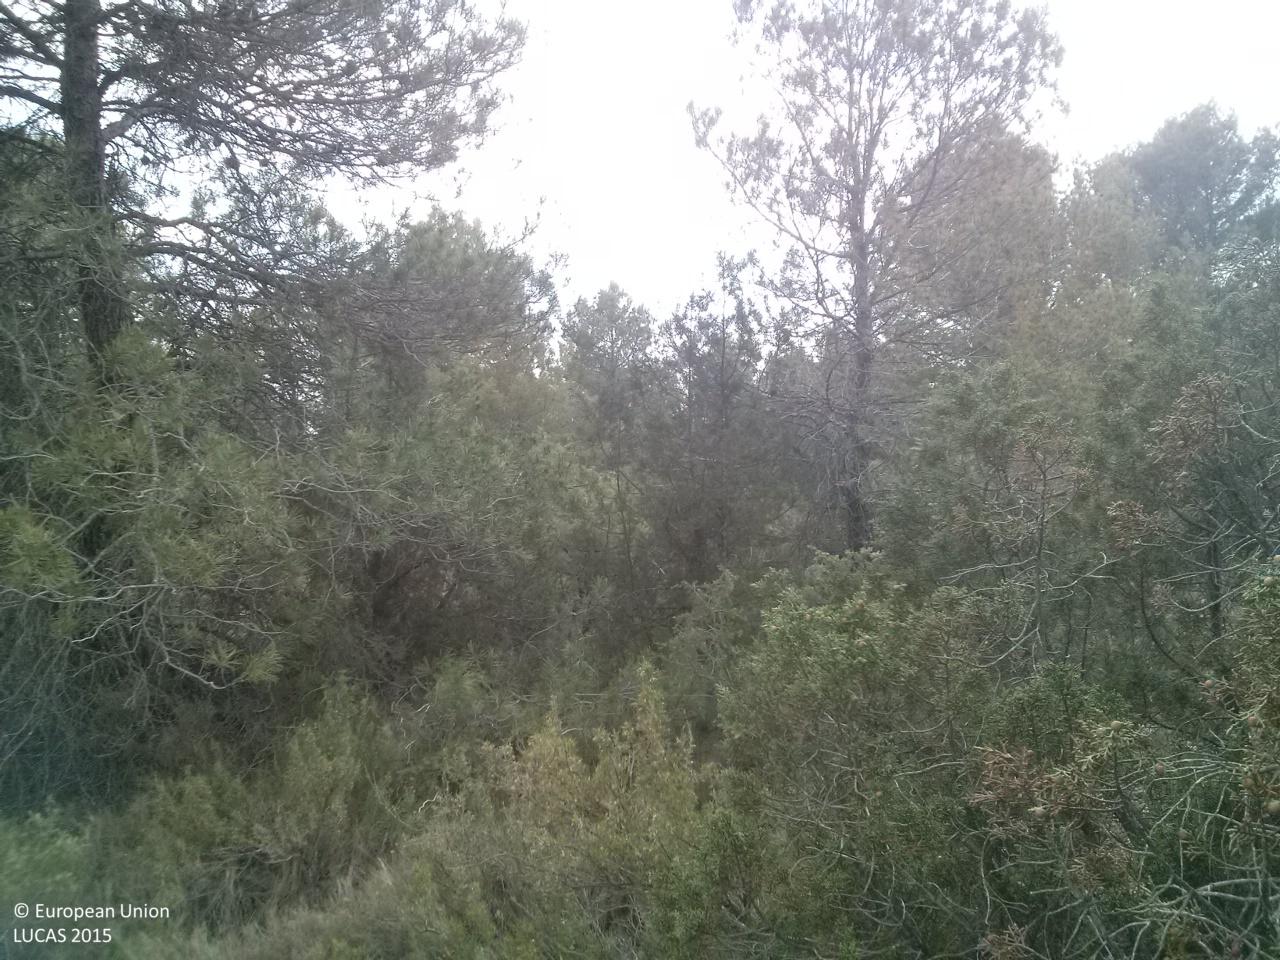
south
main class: Woodland
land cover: Pine dominated coniferous woodland
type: coniferous forest of the mediterranean region
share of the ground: 10 - 25 %
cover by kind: shrubs 50 %, coniferous forest trees 25 %, herbaceous plants 25 %
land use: Forestry
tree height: > 5 m
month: June
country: ES
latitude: 39.7580
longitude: -1.7629
